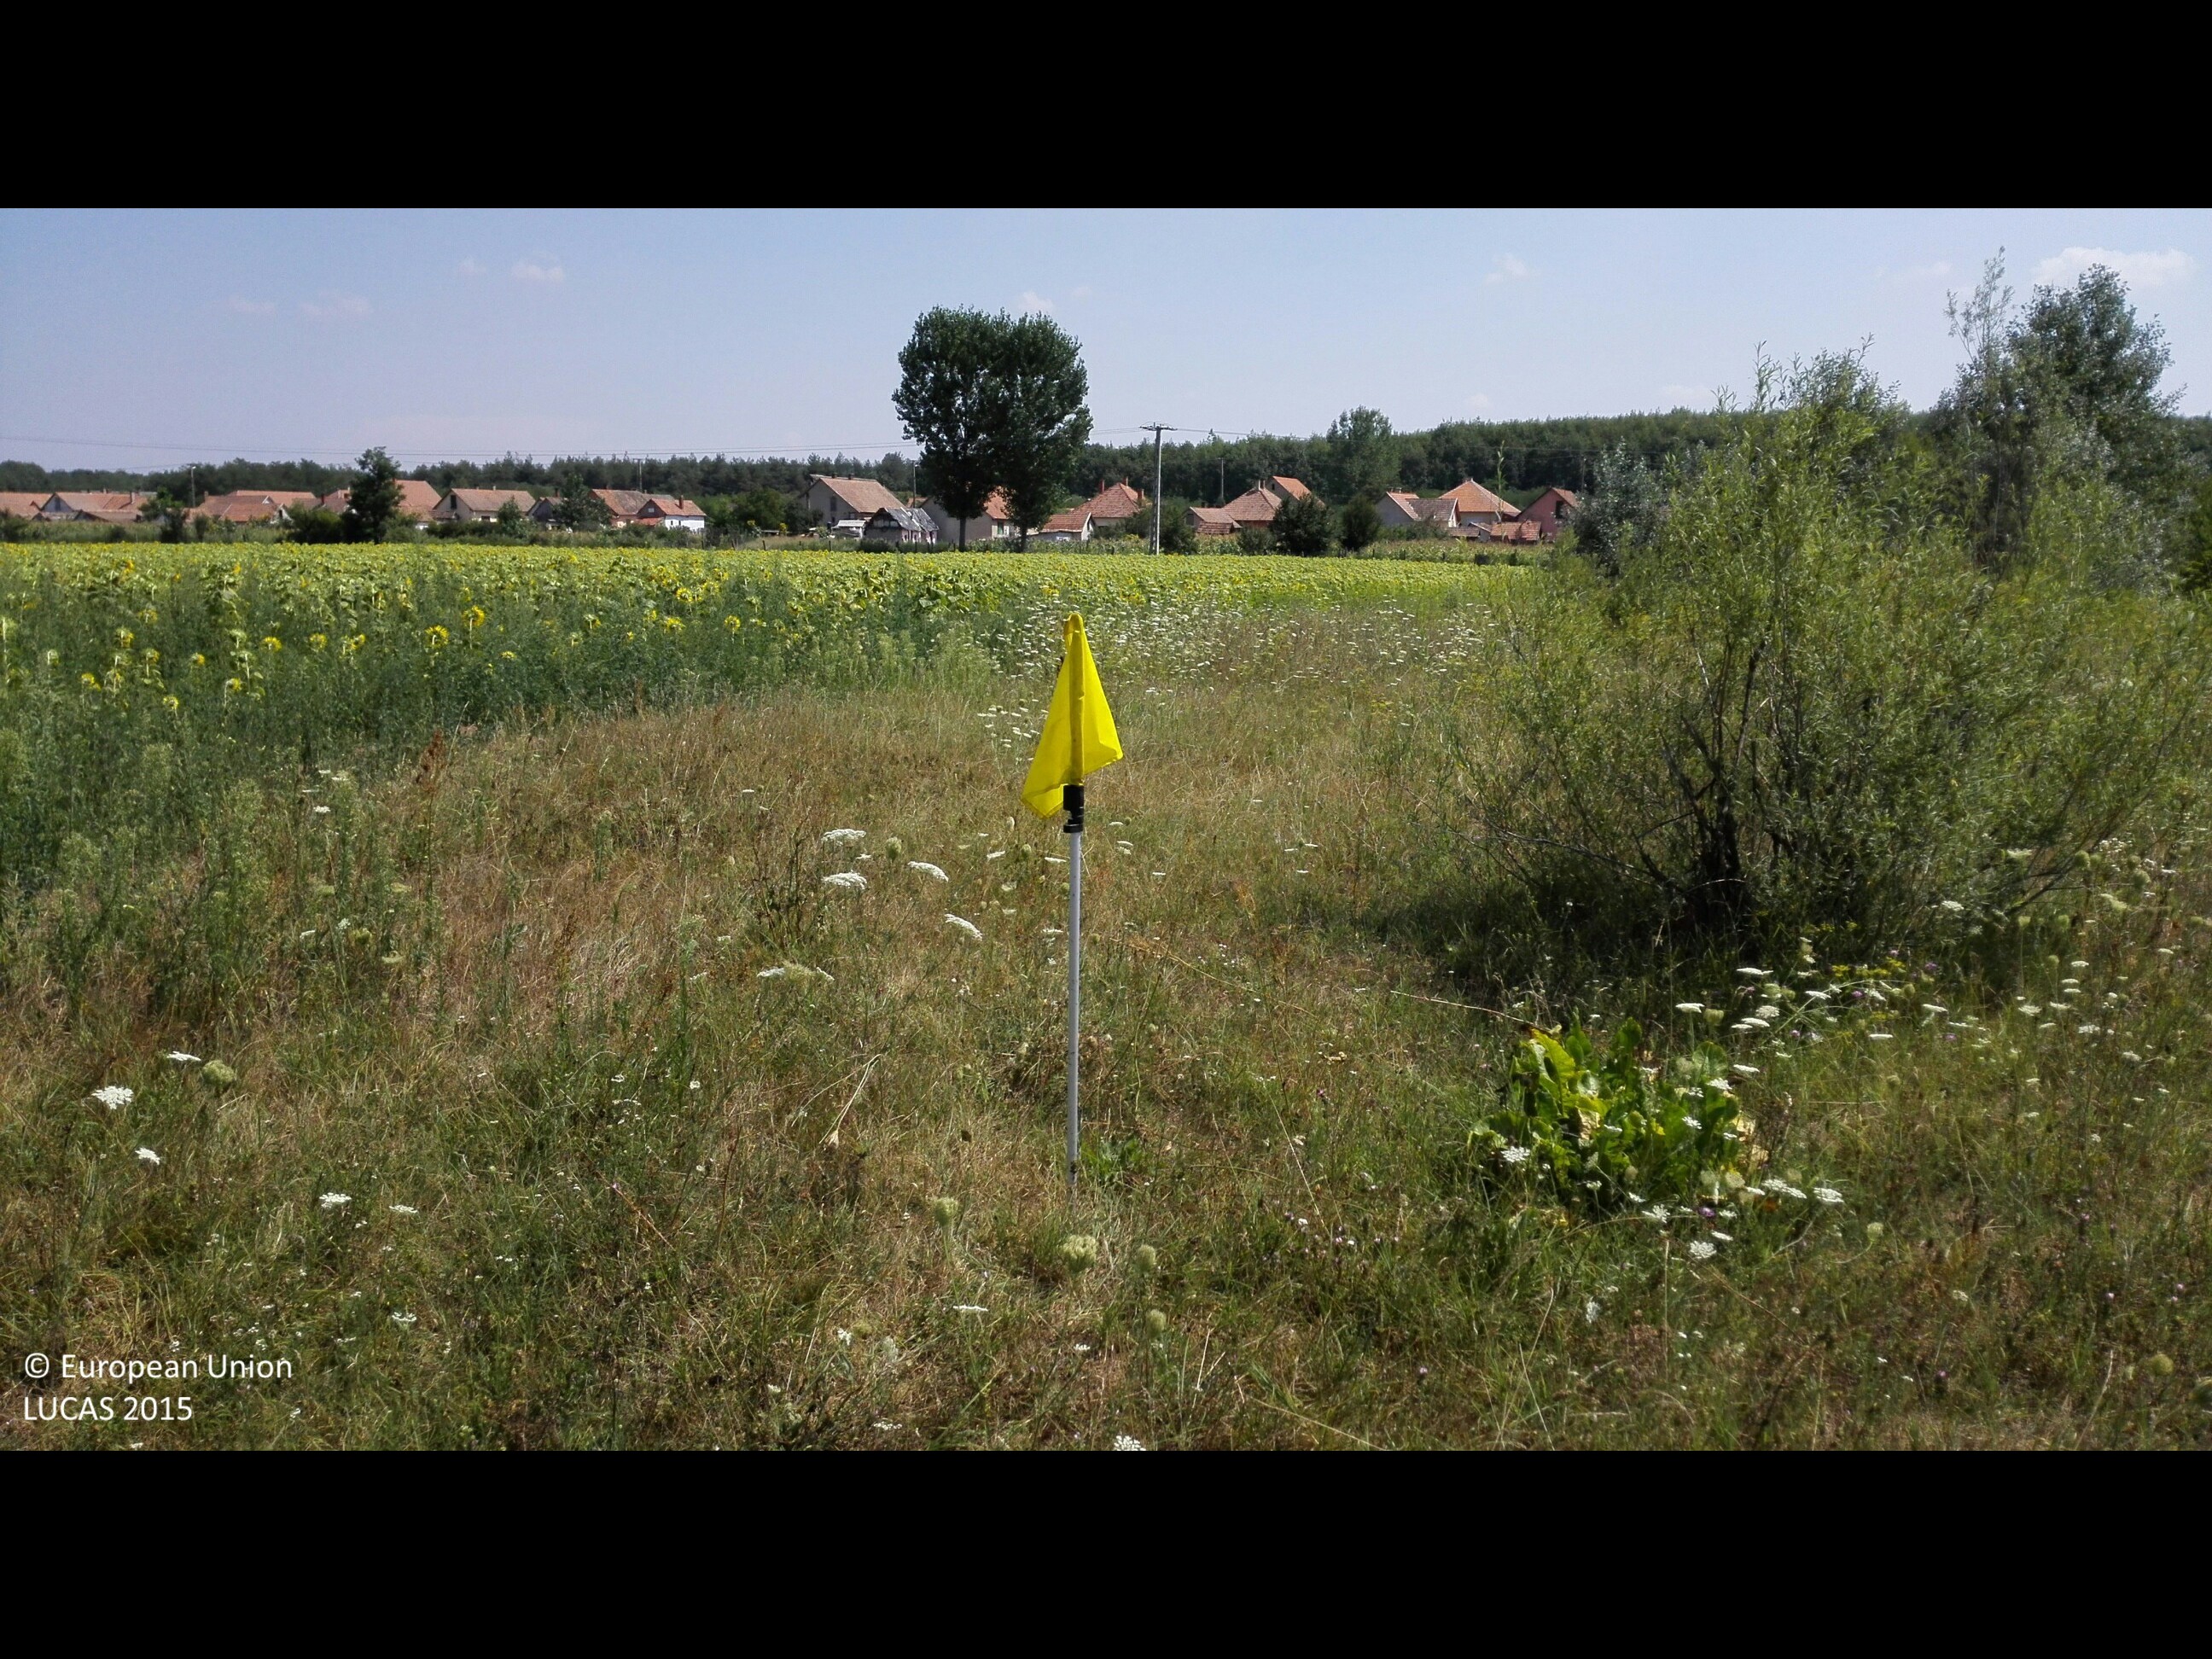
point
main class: Grassland
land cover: Grassland with sparse tree/shrub cover
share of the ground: > 75 %
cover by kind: herbaceous plants 90 %, broadleaved forest trees 5 %, shrubs 5 %
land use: Semi-natural and natural areas not in use
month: August
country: HU
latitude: 47.5625
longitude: 22.0254
